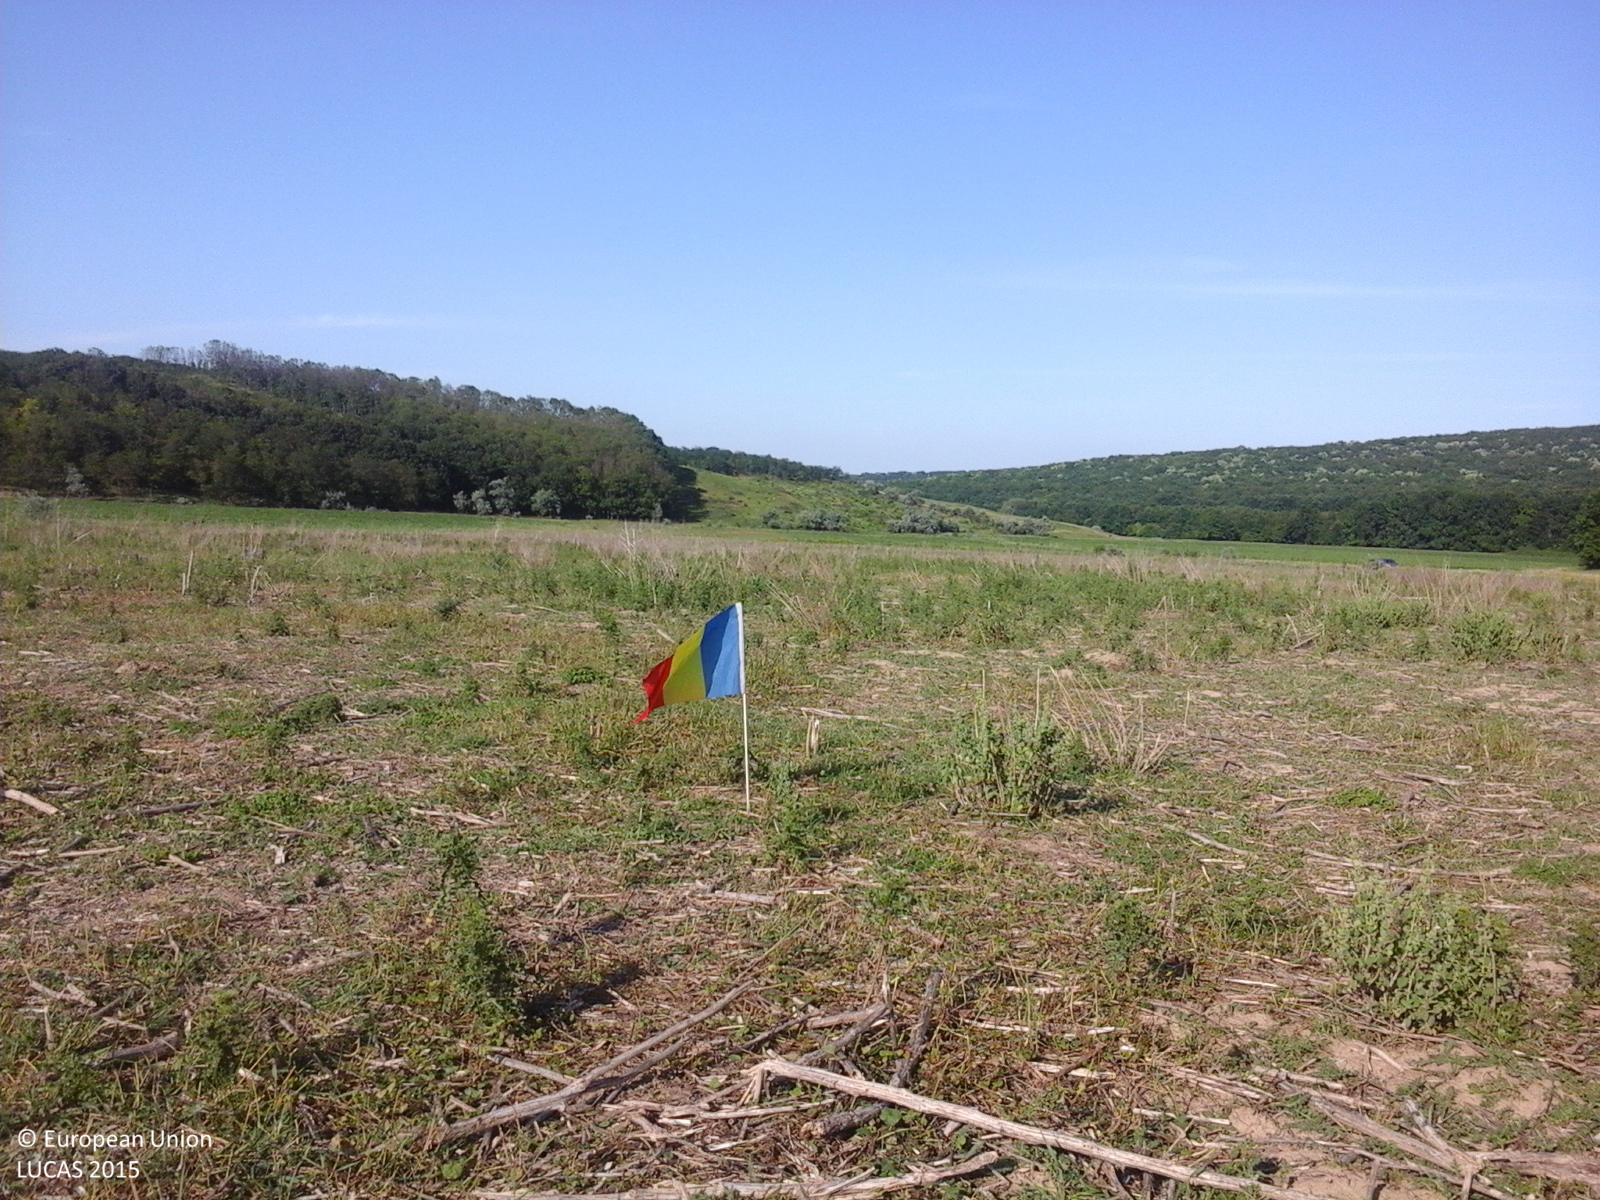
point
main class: Grassland
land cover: Spontaneously vegetated surfaces
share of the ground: > 75 %
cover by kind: herbaceous plants 100 %
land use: Agriculture (excluding fallow land and kitchen gardens)
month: June
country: RO
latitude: 47.1269
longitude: 27.0139
